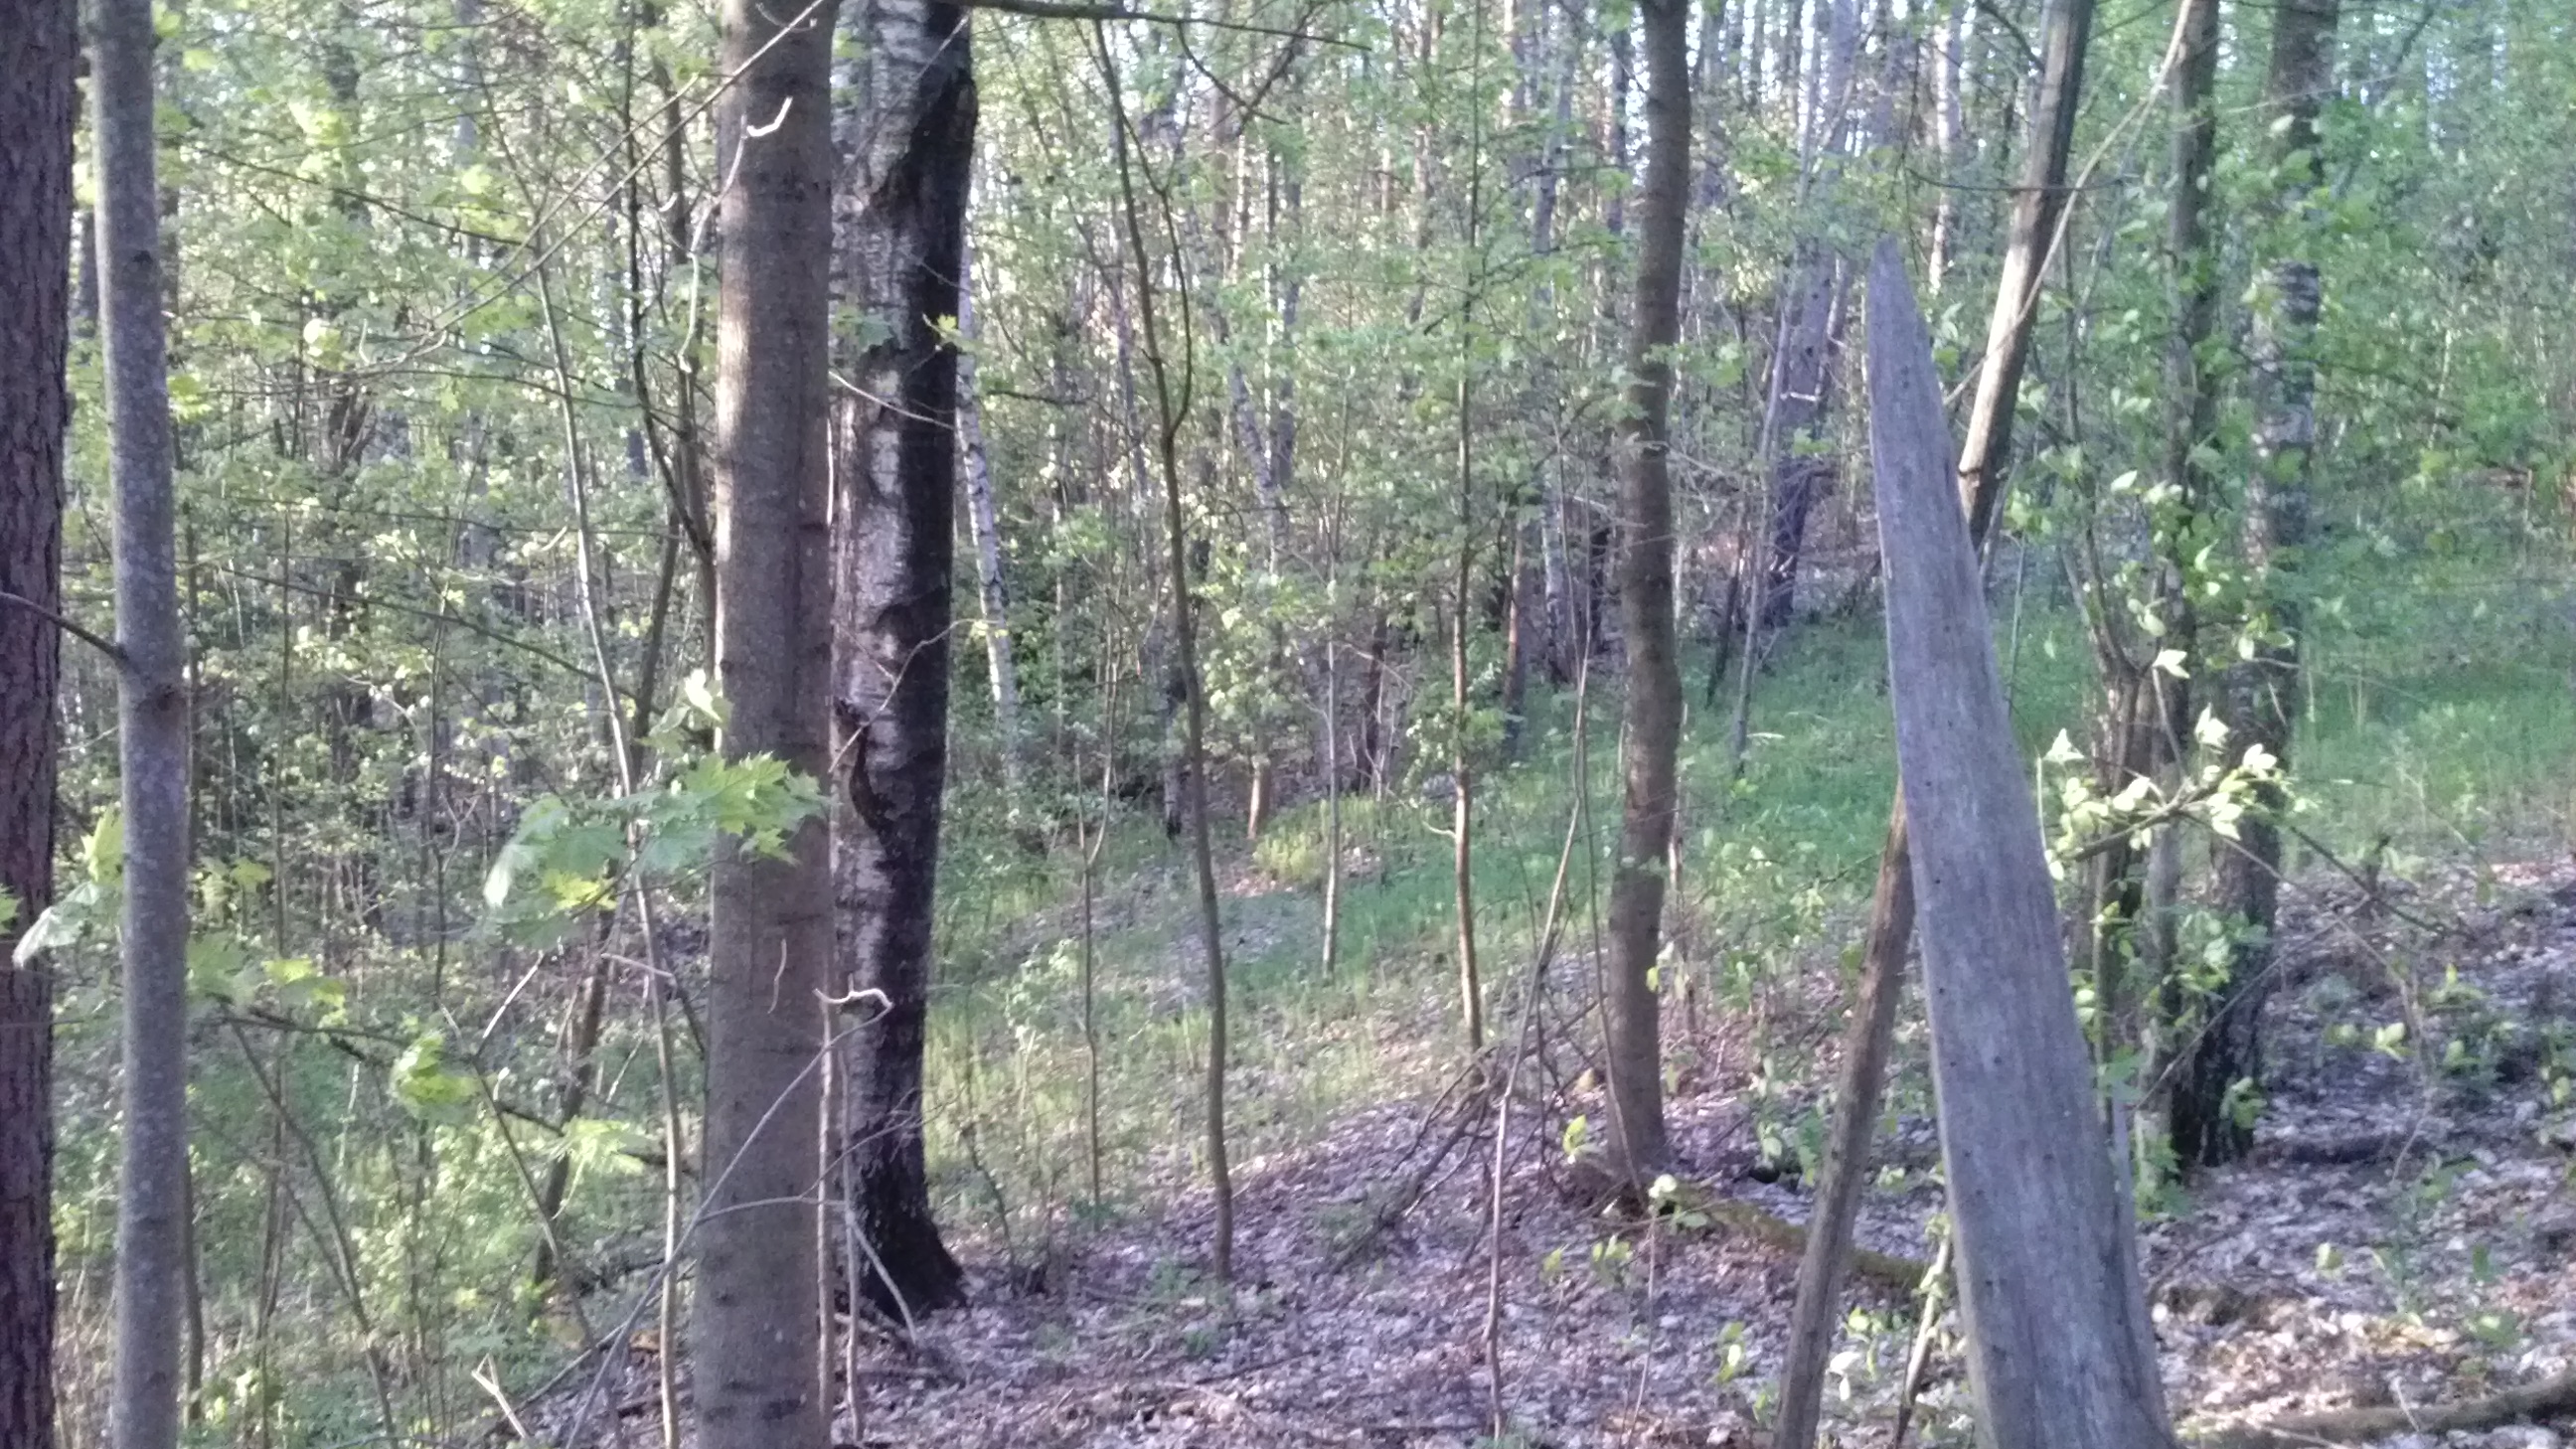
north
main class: Woodland
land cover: Broadleaved woodland
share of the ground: > 75 %
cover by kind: broadleaved forest trees 100 %
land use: Forestry
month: May
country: LV
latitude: 56.0795
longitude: 27.2200
